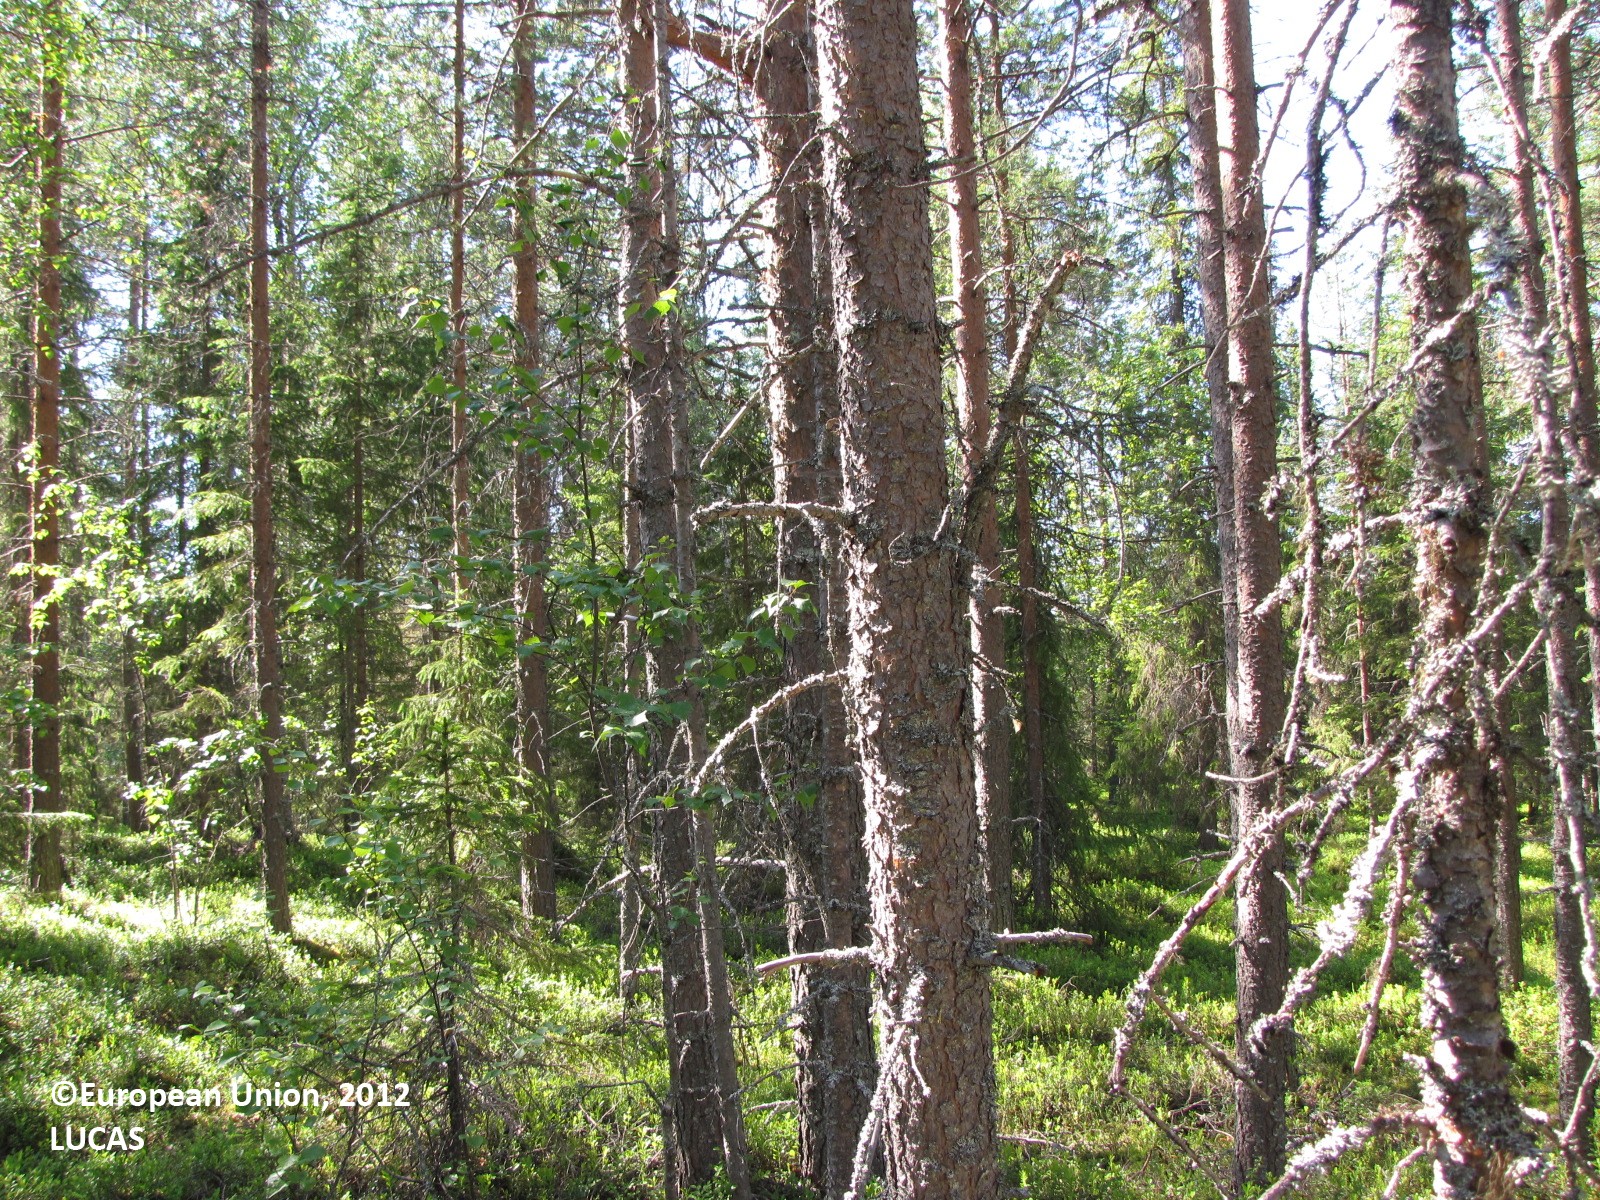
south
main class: Woodland
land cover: Pine dominated coniferous woodland
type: boreal forest
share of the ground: 50 - 75 %
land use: Forestry
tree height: > 5 m
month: July
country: FI
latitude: 66.3704
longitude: 25.2870
